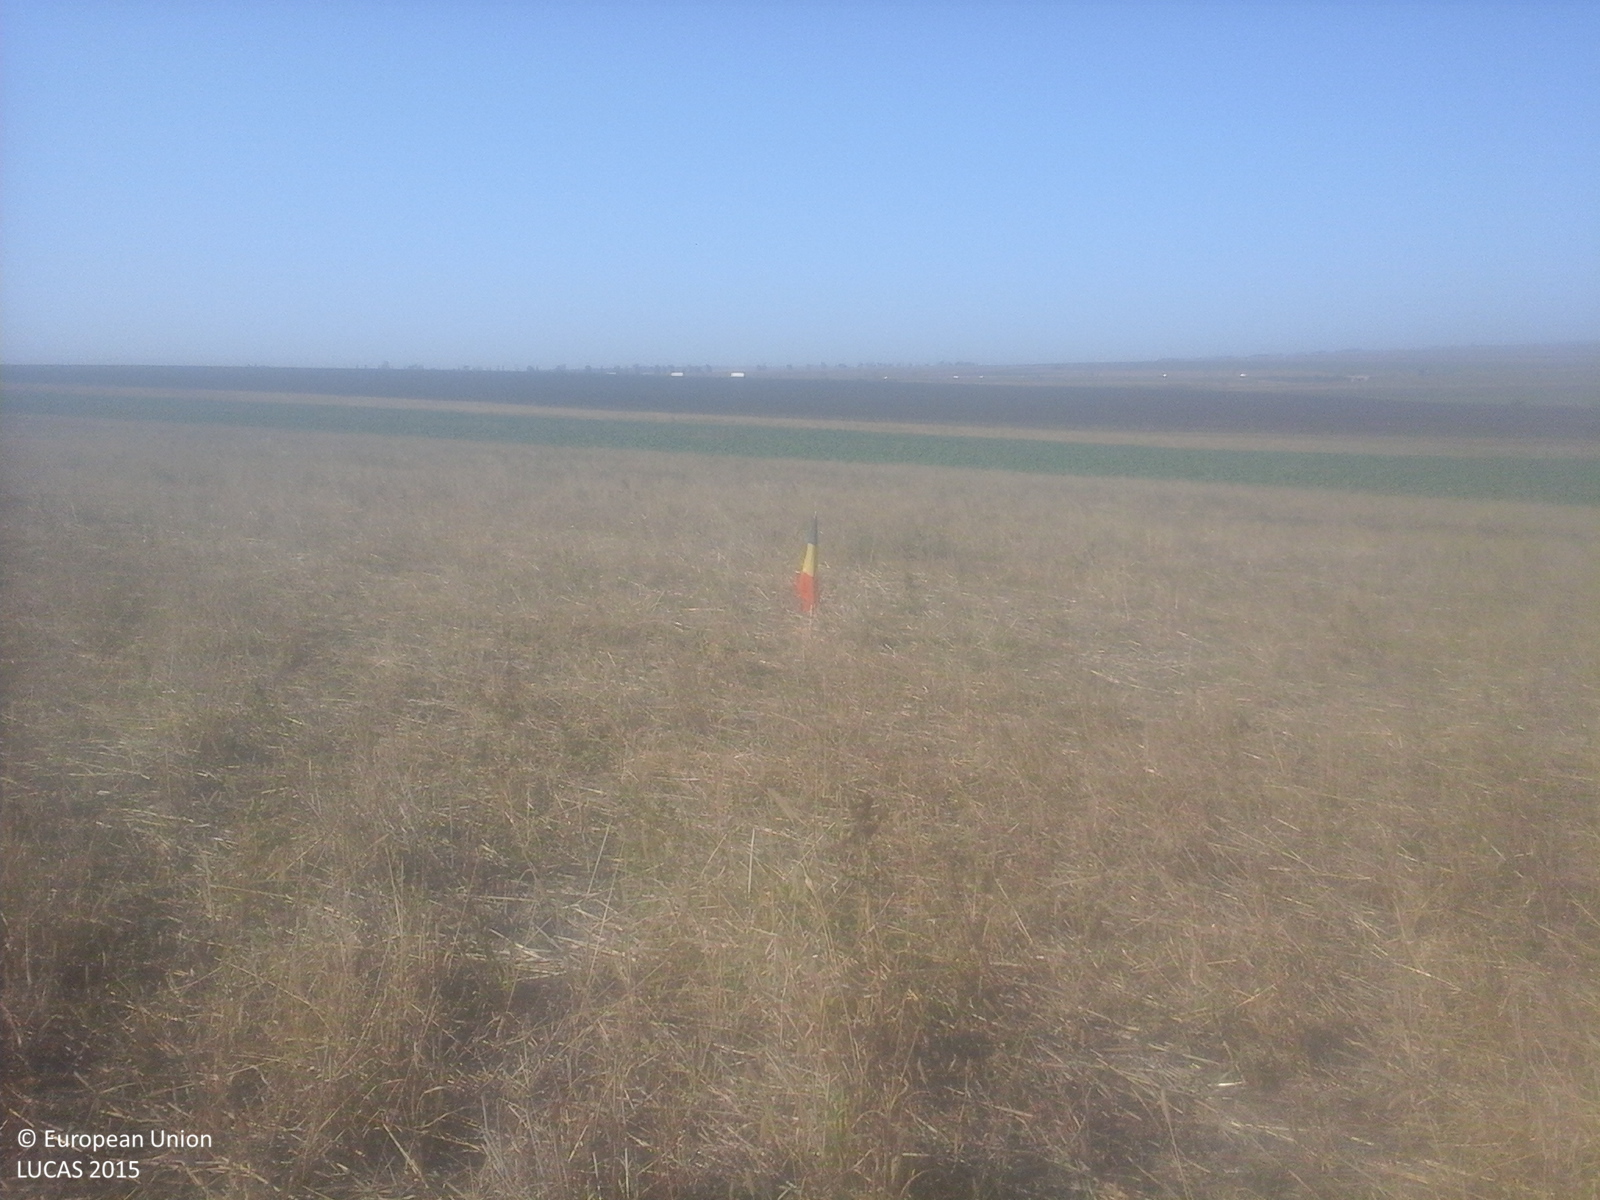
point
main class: Cropland
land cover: Common wheat
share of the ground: > 75 %
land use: Agriculture (excluding fallow land and kitchen gardens)
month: October
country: RO
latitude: 45.3149
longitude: 26.9613
